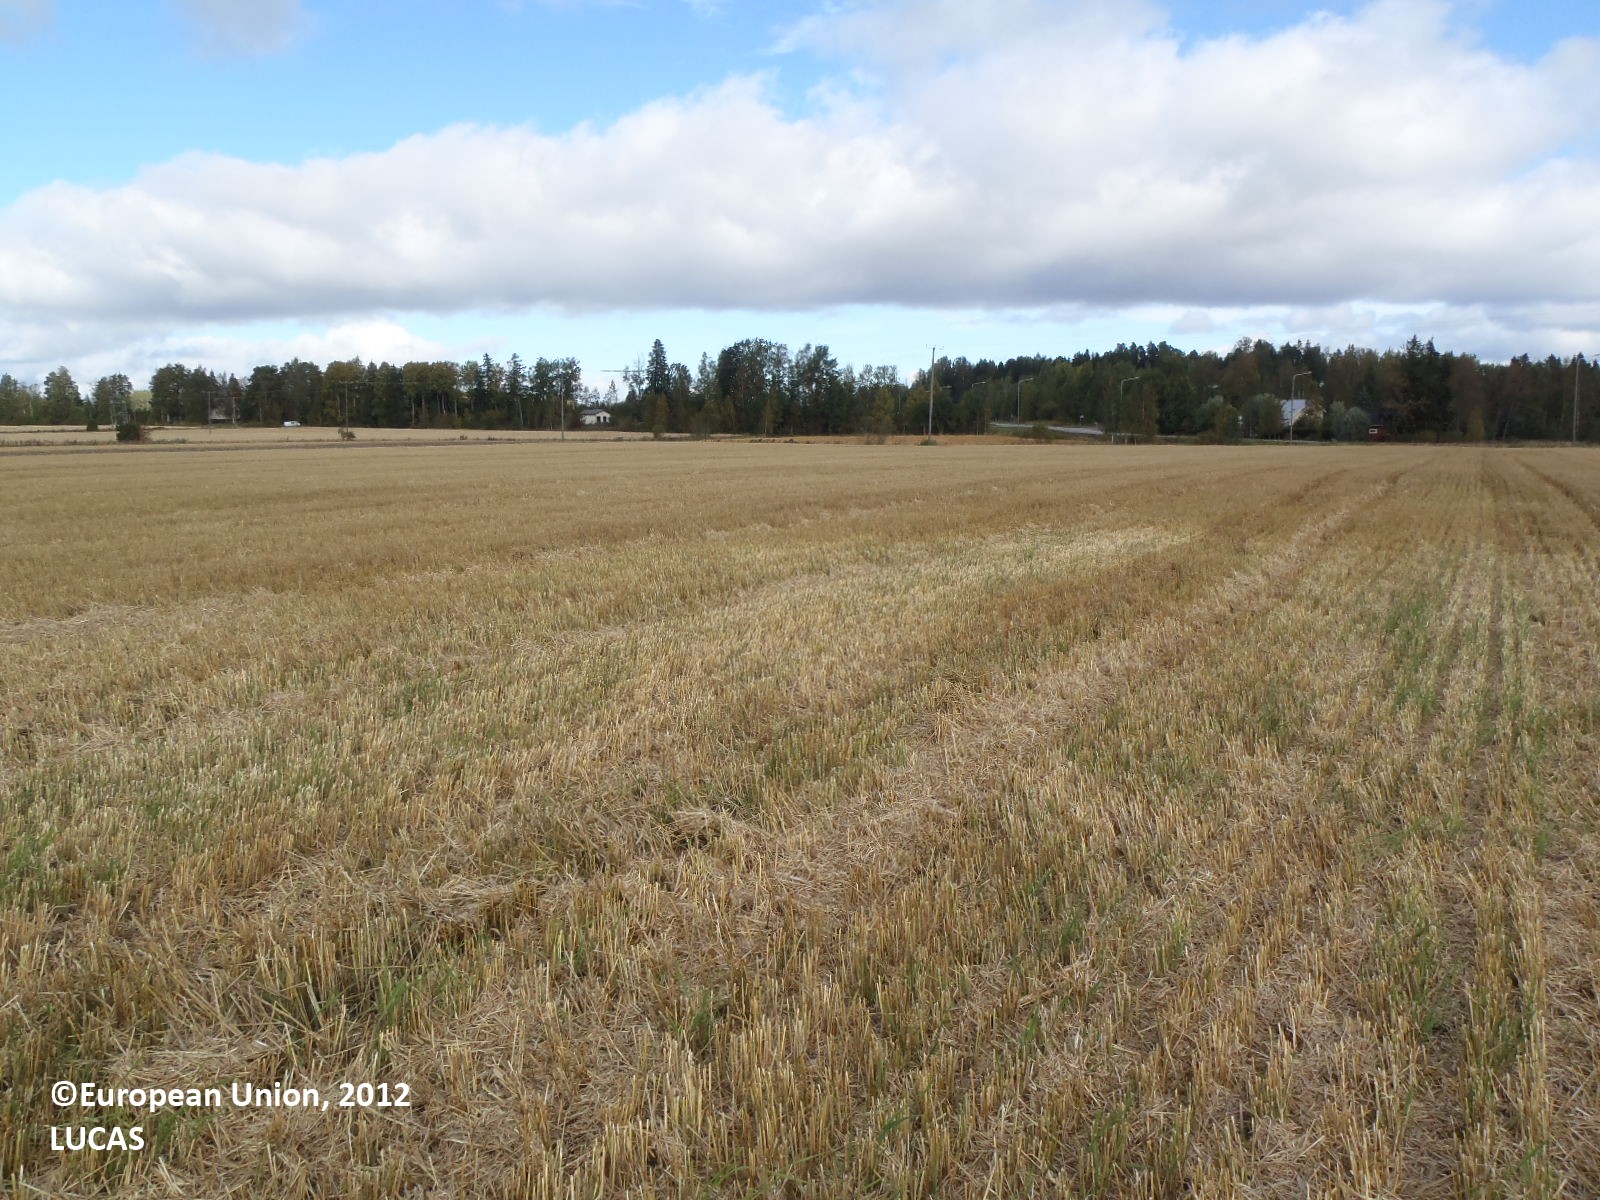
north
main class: Cropland
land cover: Barley
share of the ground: > 75 %
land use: Agriculture (excluding fallow land and kitchen gardens)
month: September
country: FI
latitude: 61.3350
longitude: 22.7575
